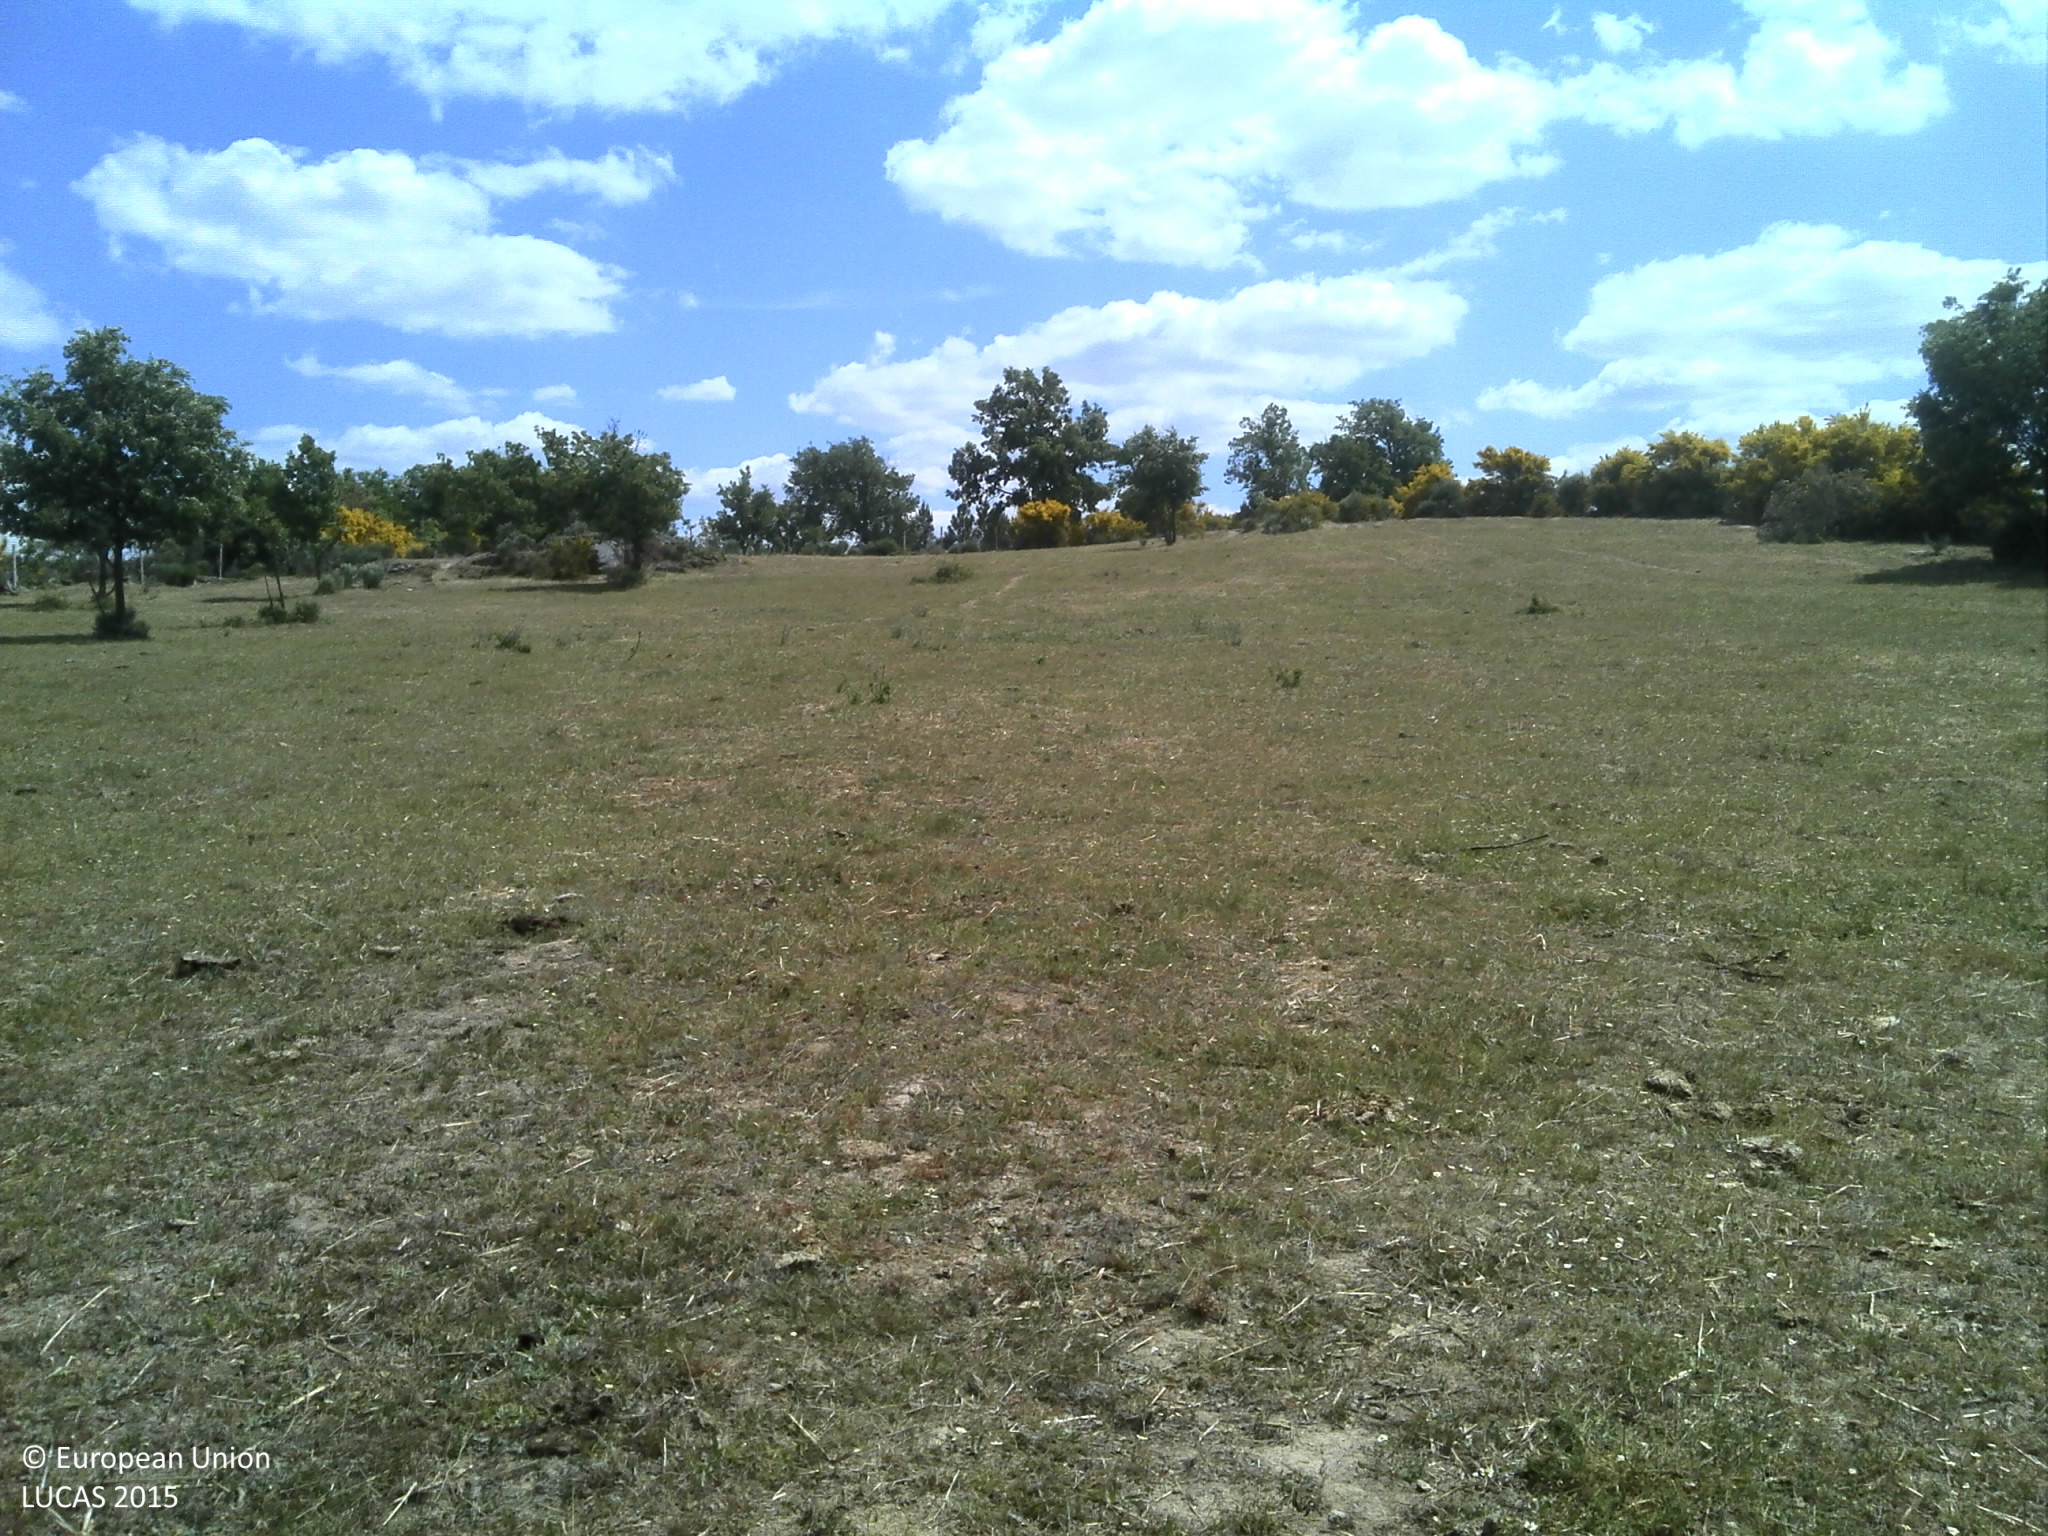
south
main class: Grassland
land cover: Grassland without tree/shrub cover
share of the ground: 25 - 50 %
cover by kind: herbaceous plants 70 %, unconsolidated bare surface 15 %
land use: Agriculture (excluding fallow land and kitchen gardens)
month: May
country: PT
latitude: 40.6665
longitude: -7.1266
